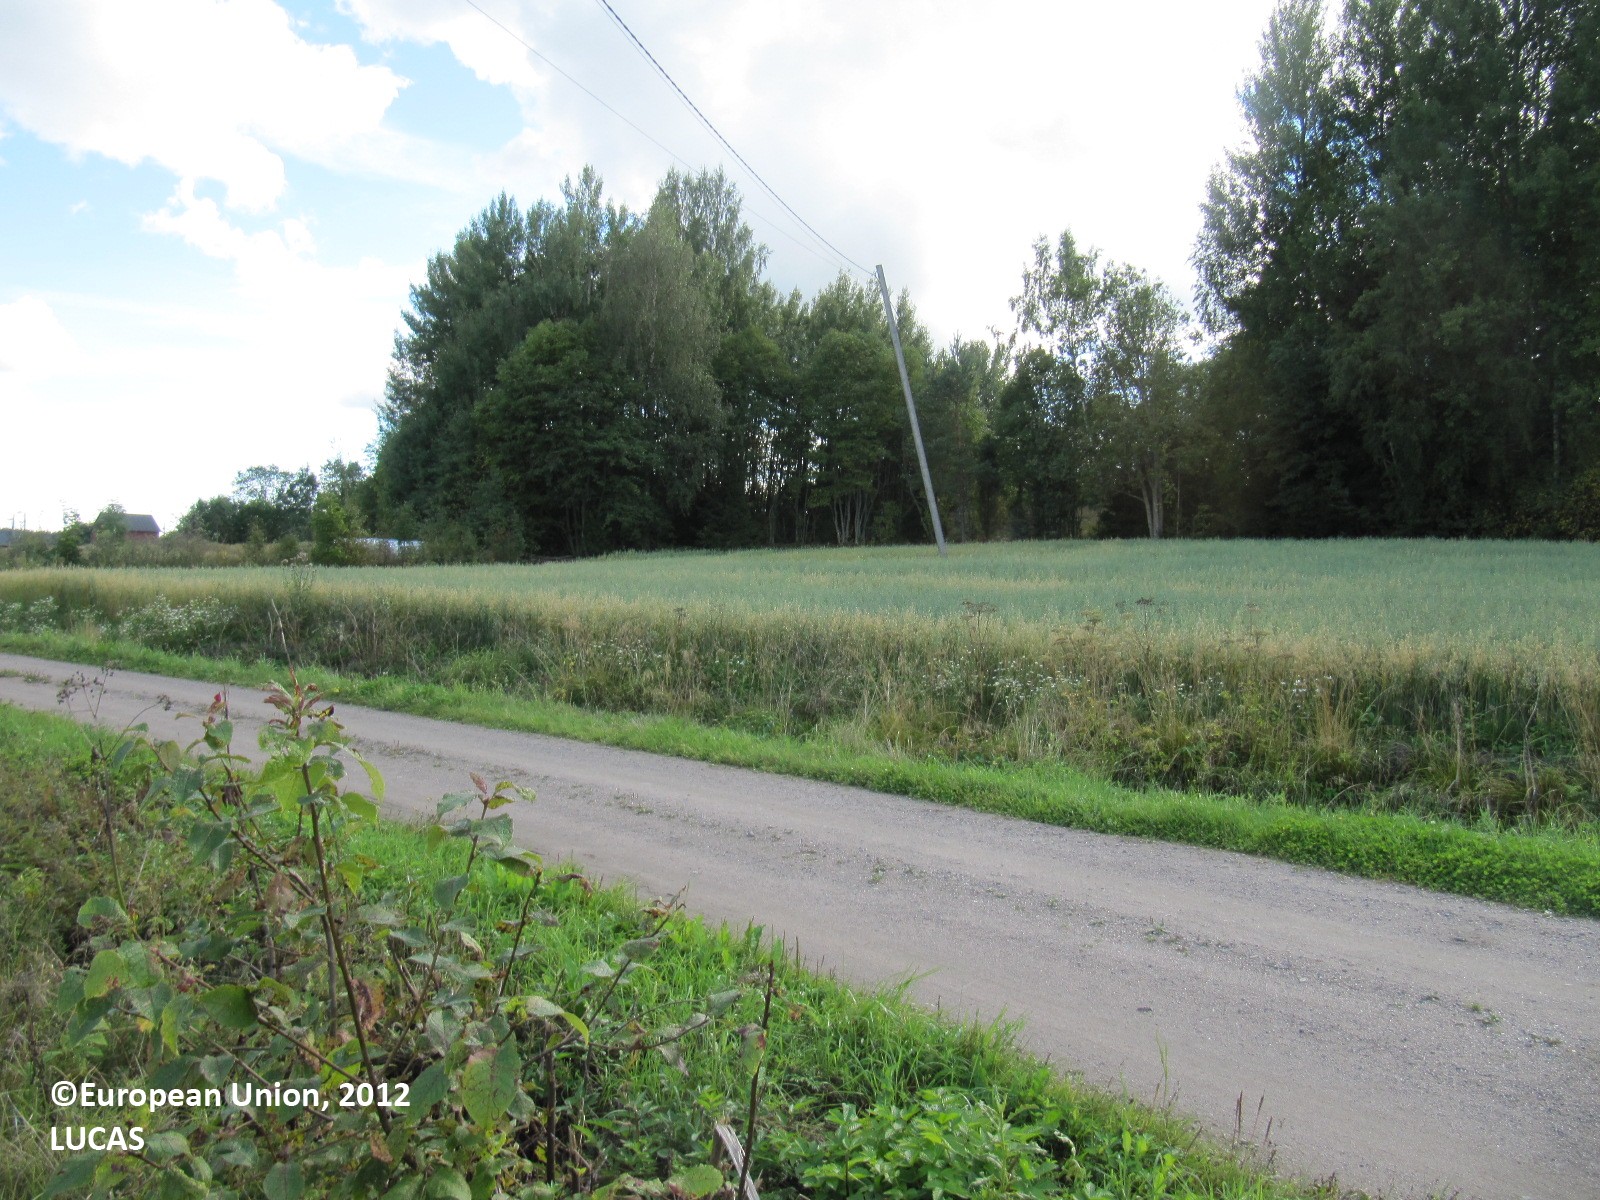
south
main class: Cropland
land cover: Oats
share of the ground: > 75 %
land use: Agriculture (excluding fallow land and kitchen gardens)
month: August
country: FI
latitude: 60.1603
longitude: 23.7692
